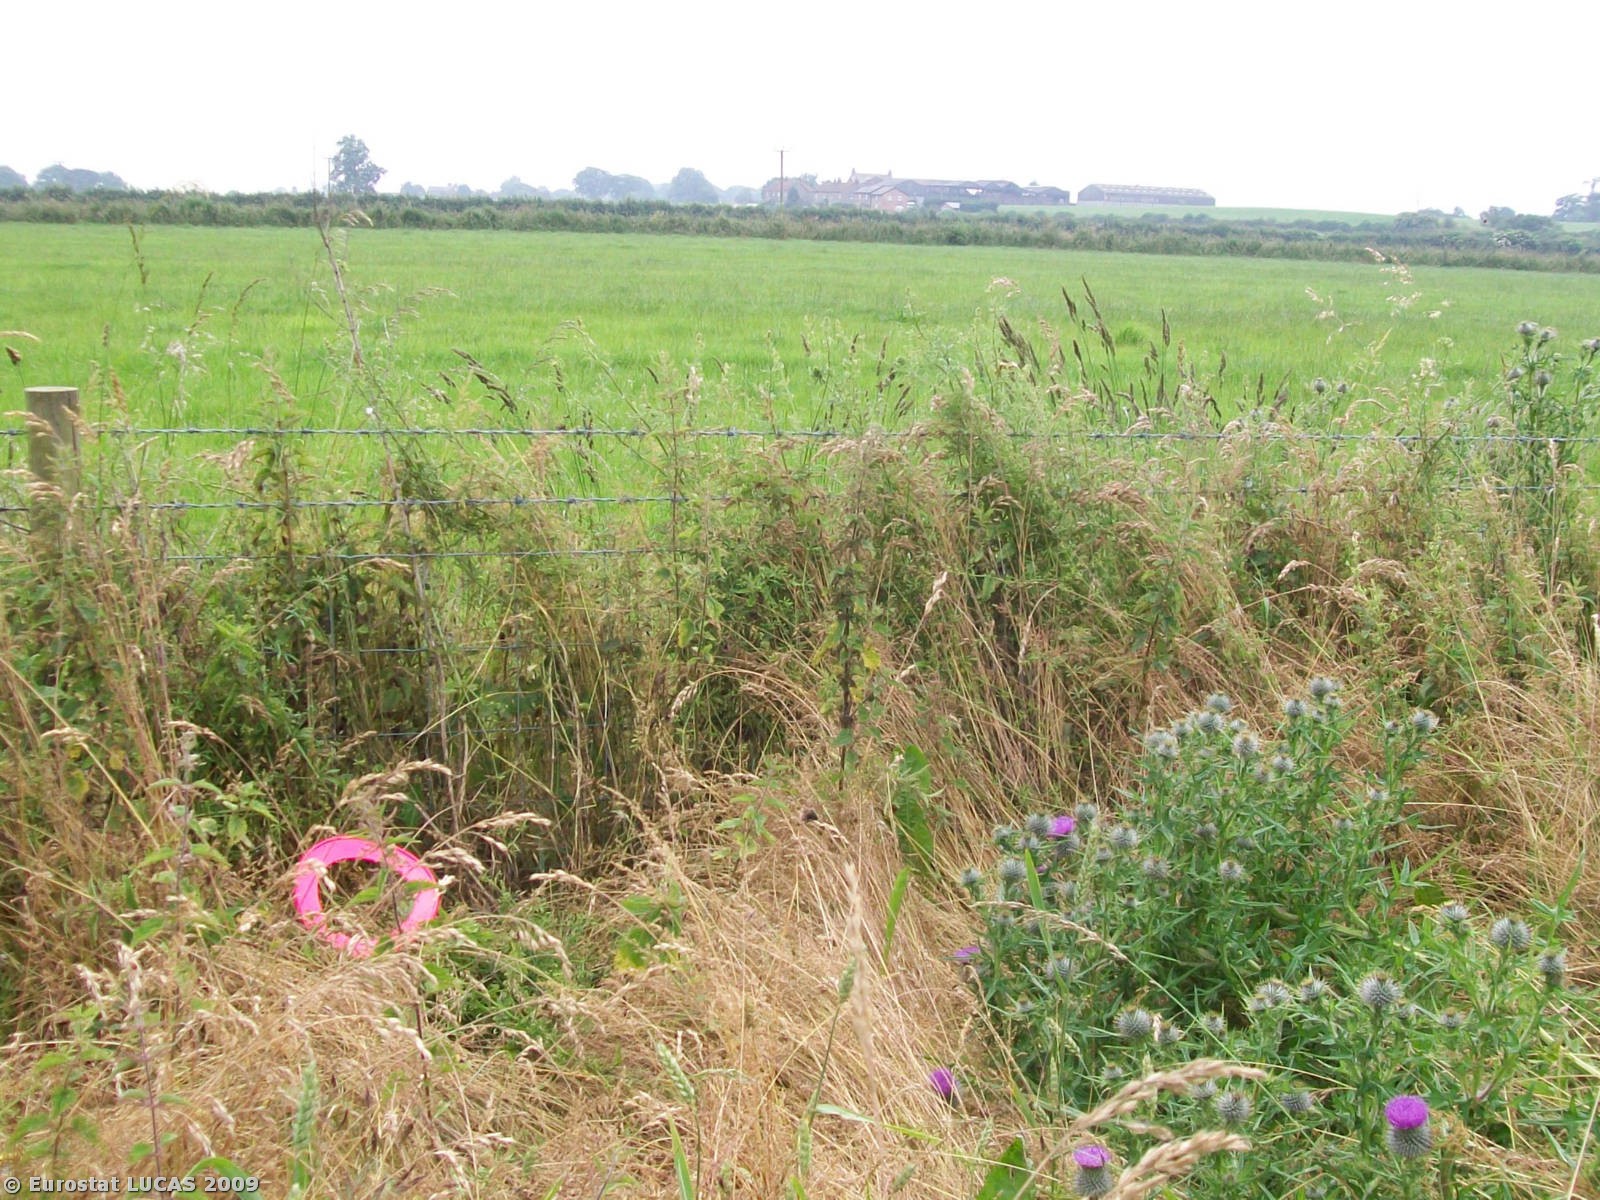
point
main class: Grassland
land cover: Grassland without tree/shrub cover
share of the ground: < 10 %
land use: Agriculture (excluding fallow land and kitchen gardens)
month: June
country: GB
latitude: 54.0401
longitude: -1.4246
